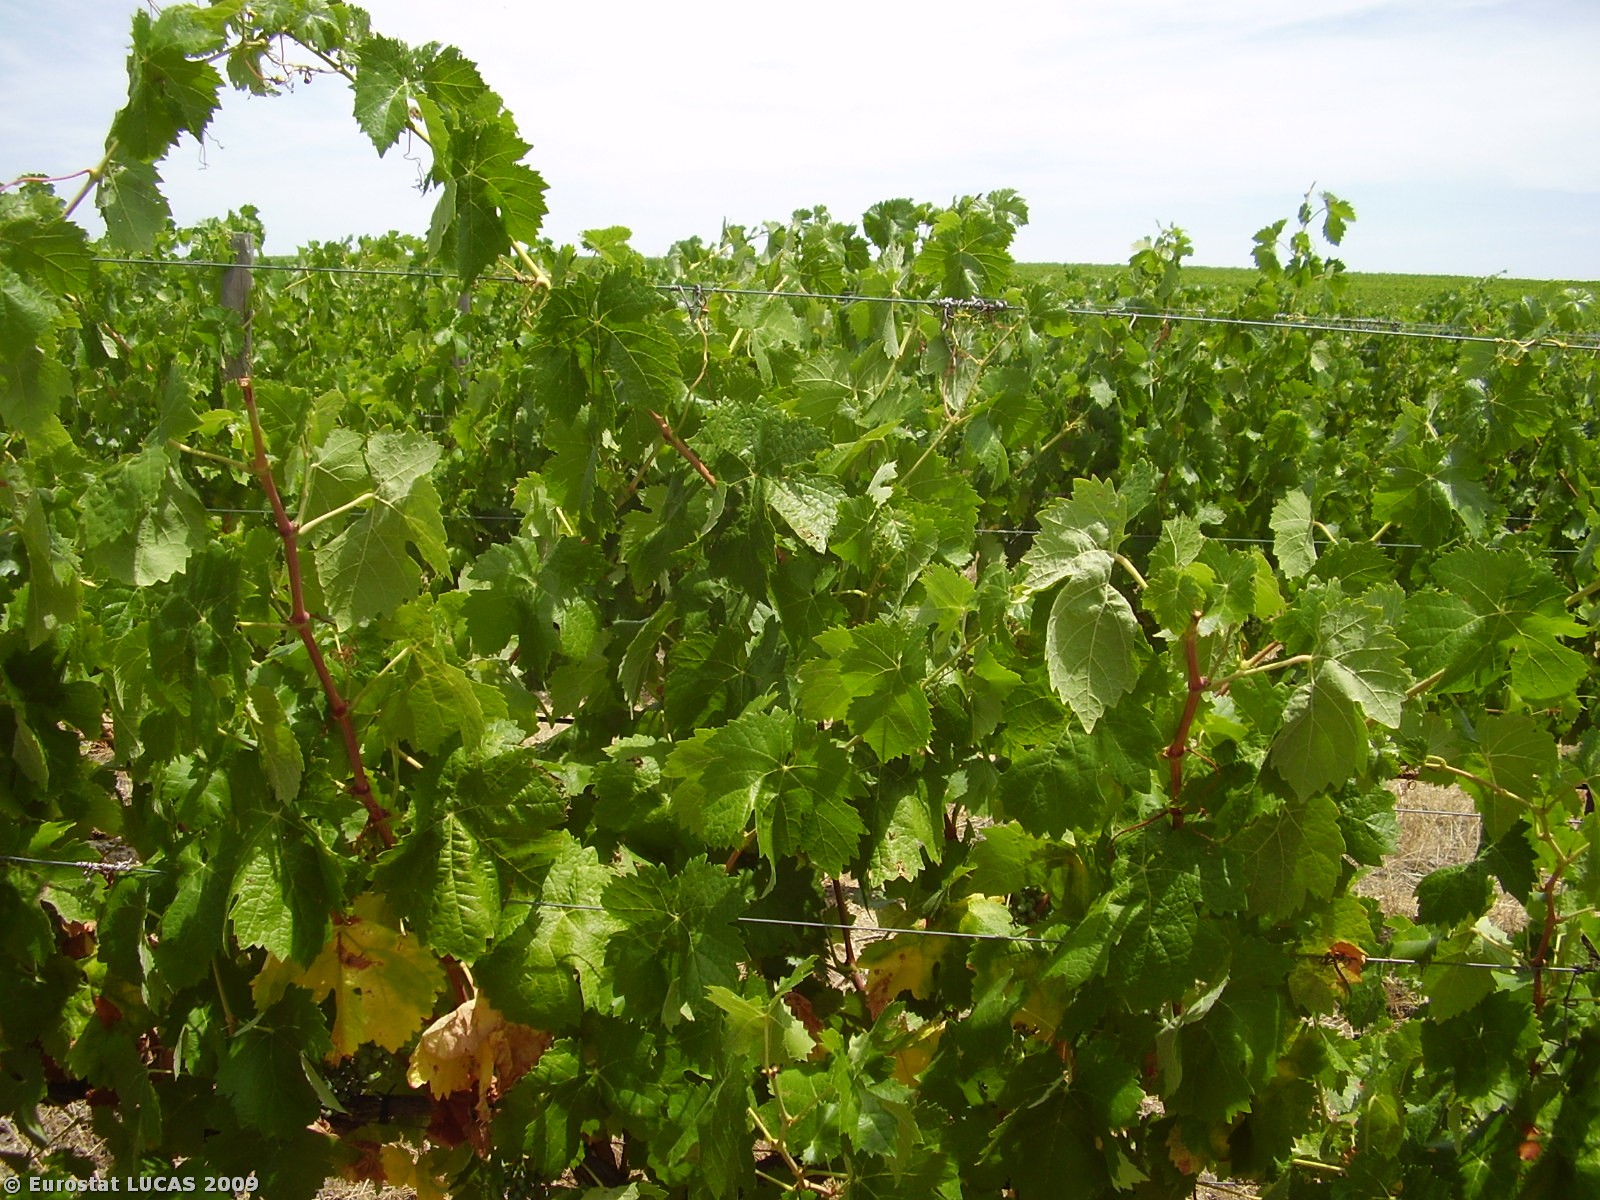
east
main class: Cropland
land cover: Vineyards
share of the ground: 10 - 25 %
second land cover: Spontaneously vegetated surfaces
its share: 50 - 75 %
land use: Agriculture (excluding fallow land and kitchen gardens)
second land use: Fallow land
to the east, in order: Vineyards; Spontaneously vegetated surfaces; Vineyards
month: July
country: PT
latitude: 38.5447
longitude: -7.8325
